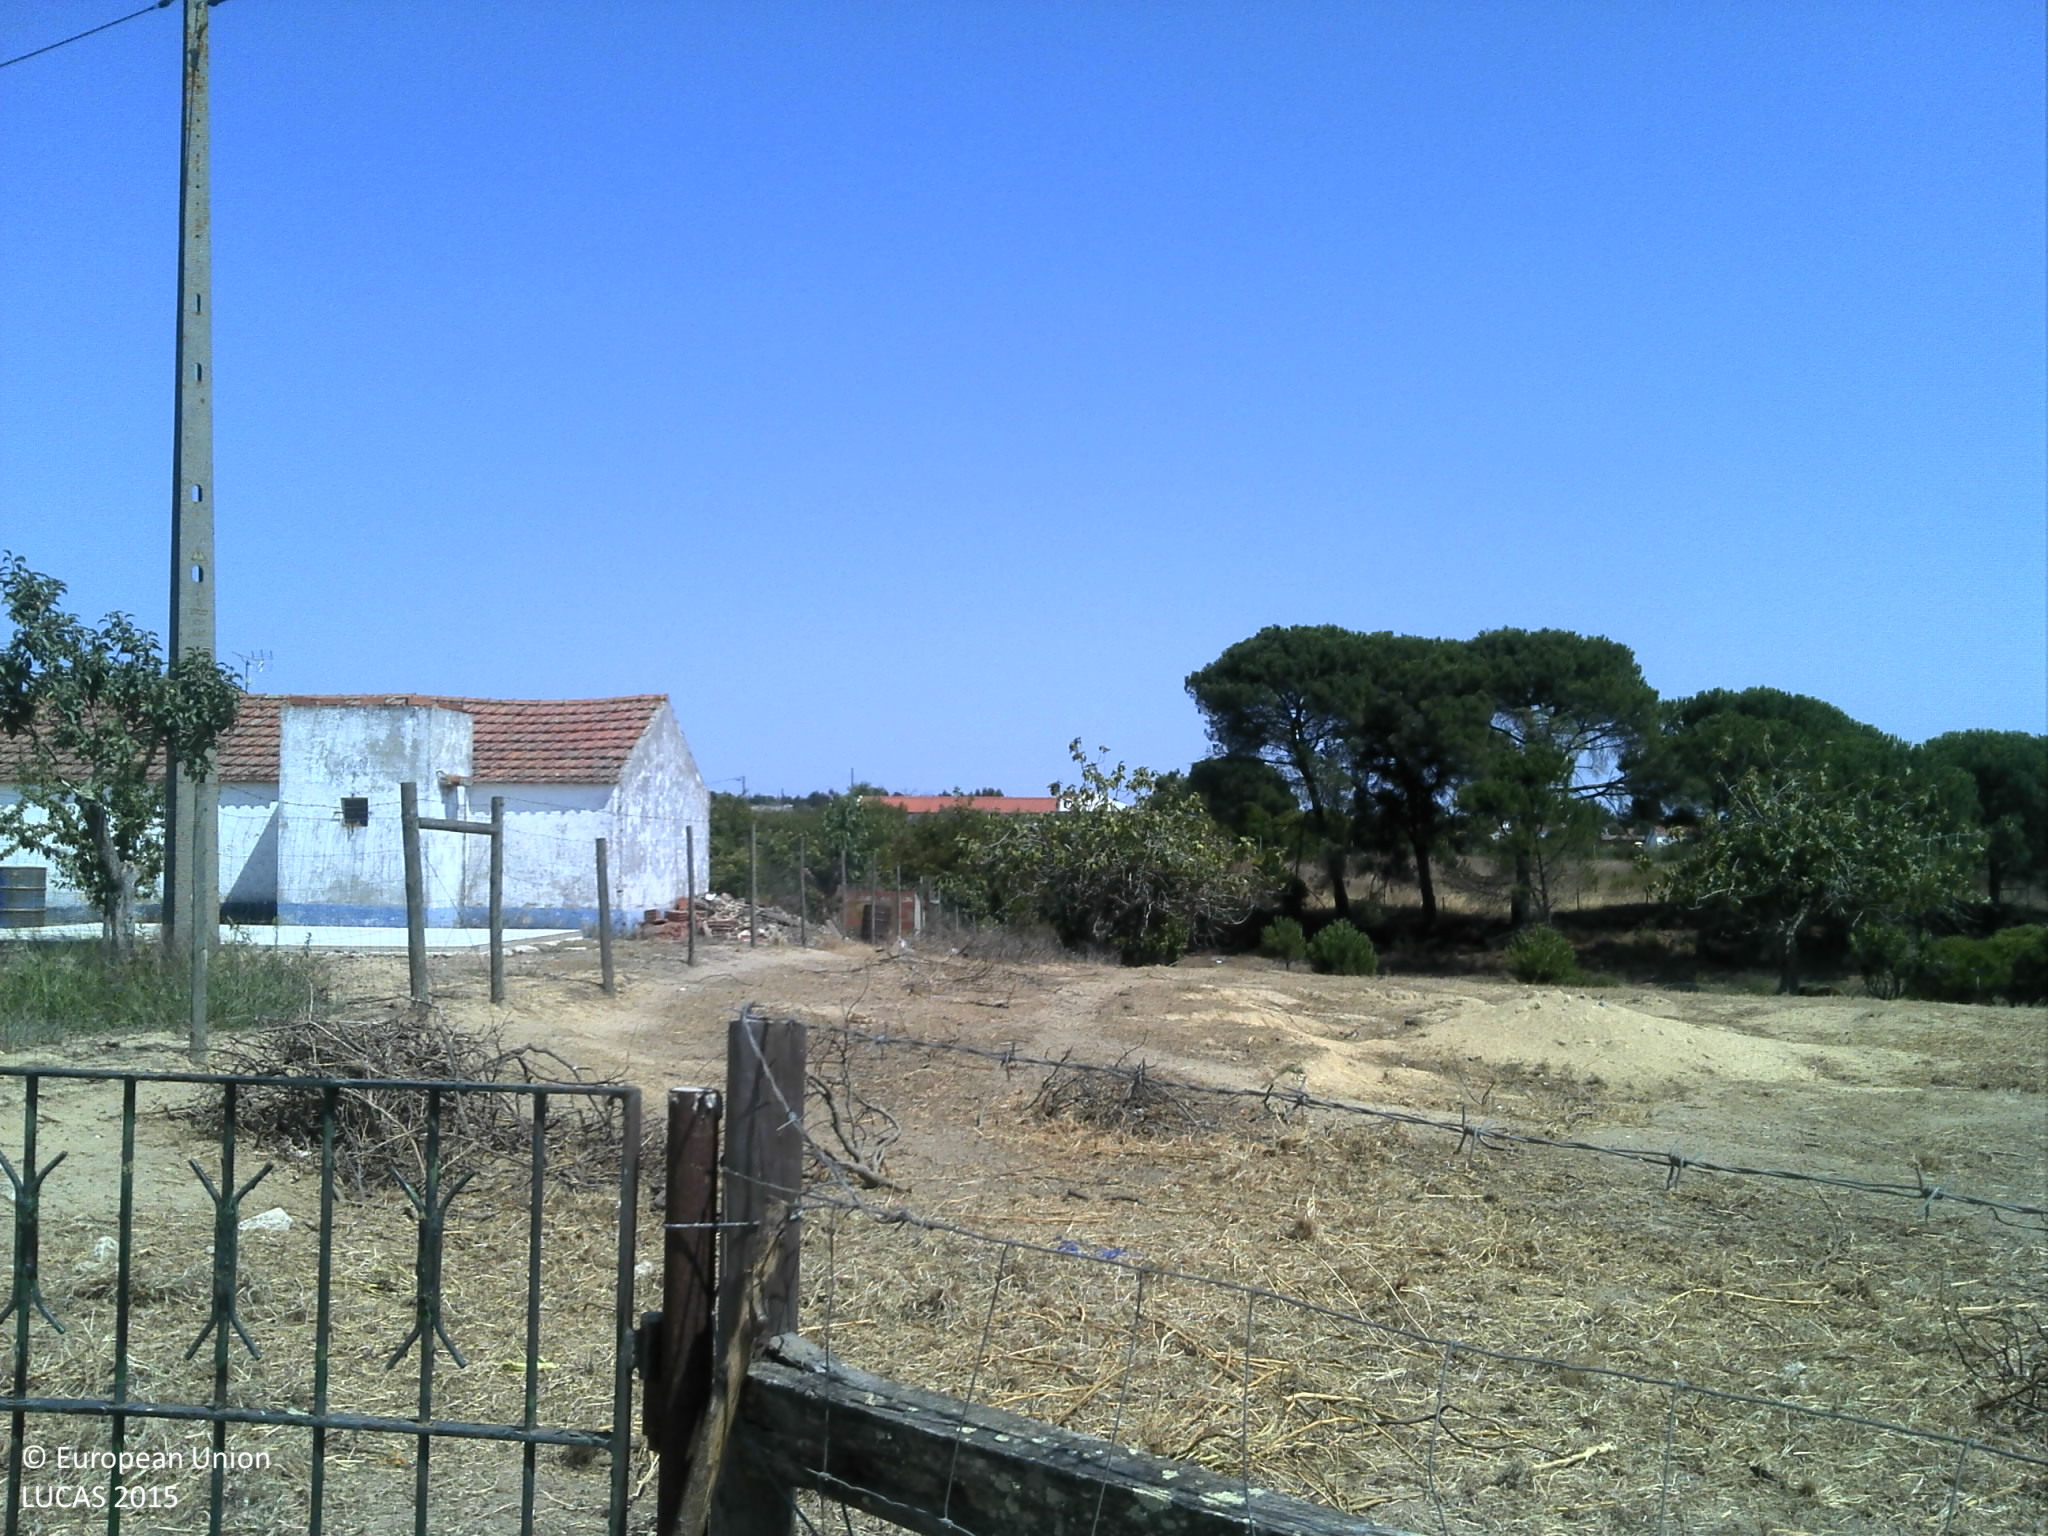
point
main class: Cropland
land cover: Other fruit trees and berries
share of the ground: 25 - 50 %
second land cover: Grassland without tree/shrub cover
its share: 25 - 50 %
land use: Agriculture (excluding fallow land and kitchen gardens)
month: August
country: PT
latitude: 38.6790
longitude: -8.5770
